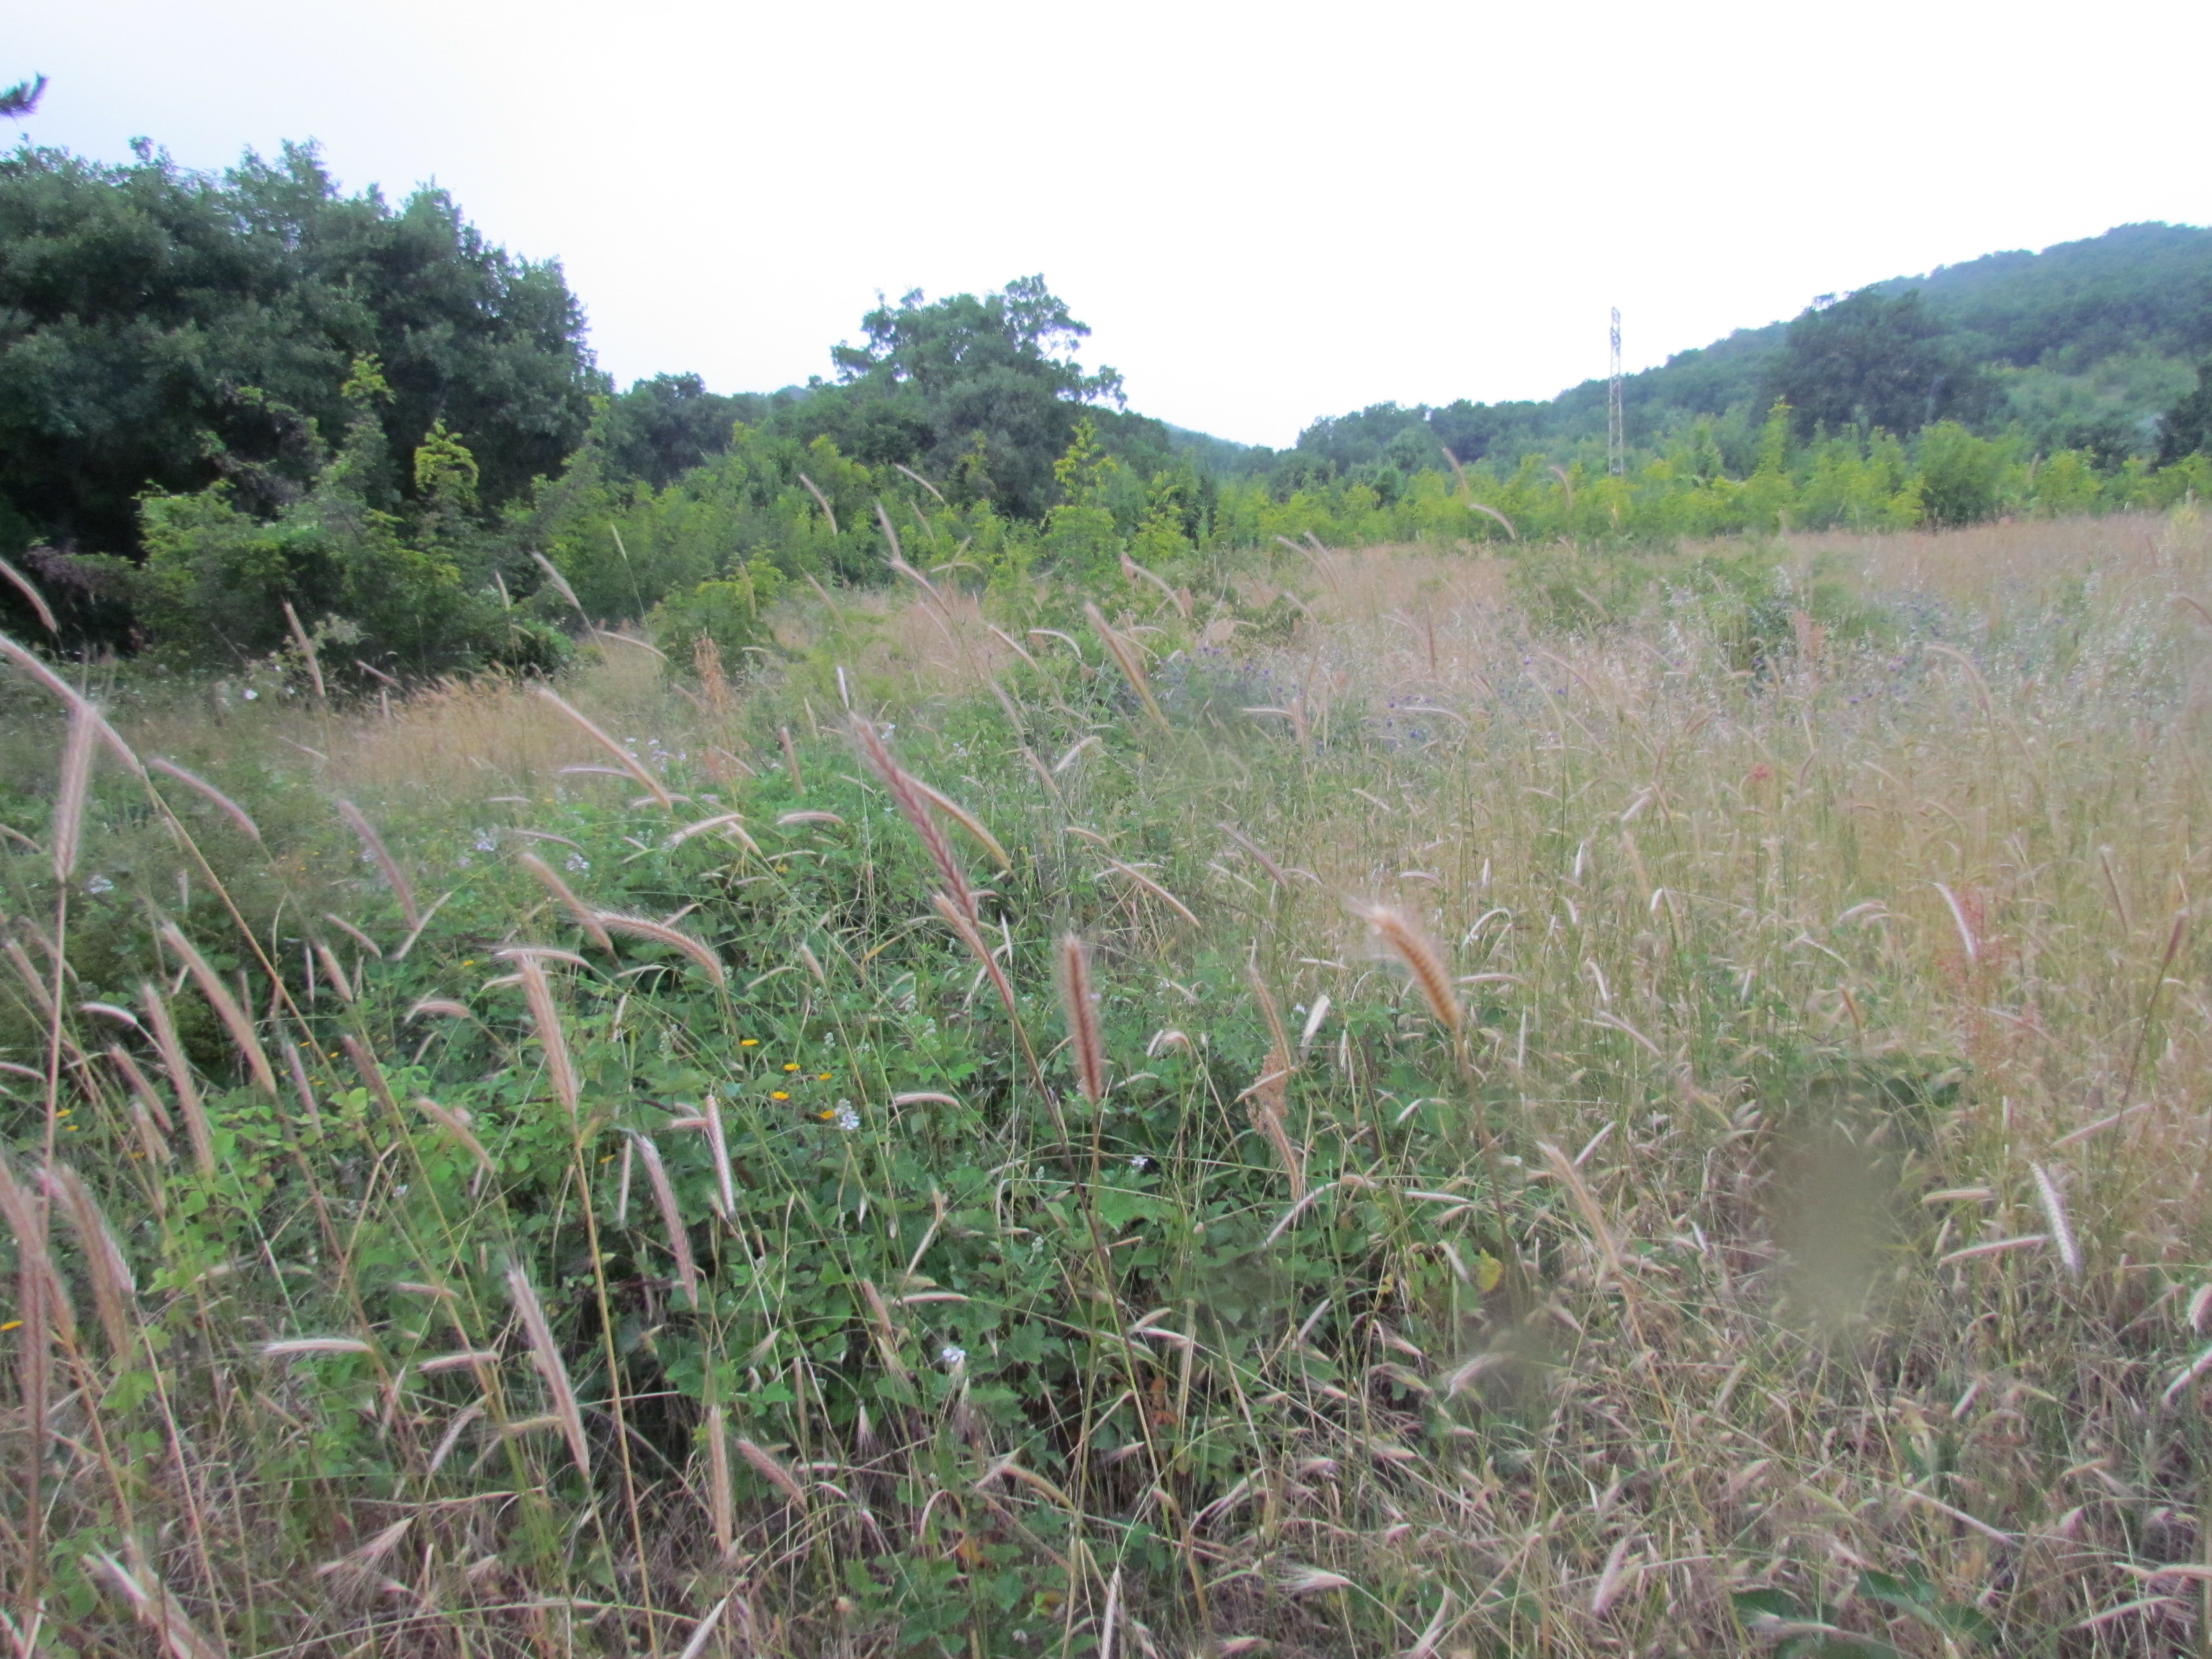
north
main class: Grassland
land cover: Grassland with sparse tree/shrub cover
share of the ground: > 75 %
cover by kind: herbaceous plants 90 %, broadleaved forest trees 5 %, shrubs 5 %
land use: Semi-natural and natural areas not in use
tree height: > 5 m
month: June
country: BG
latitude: 42.7050
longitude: 27.7946
